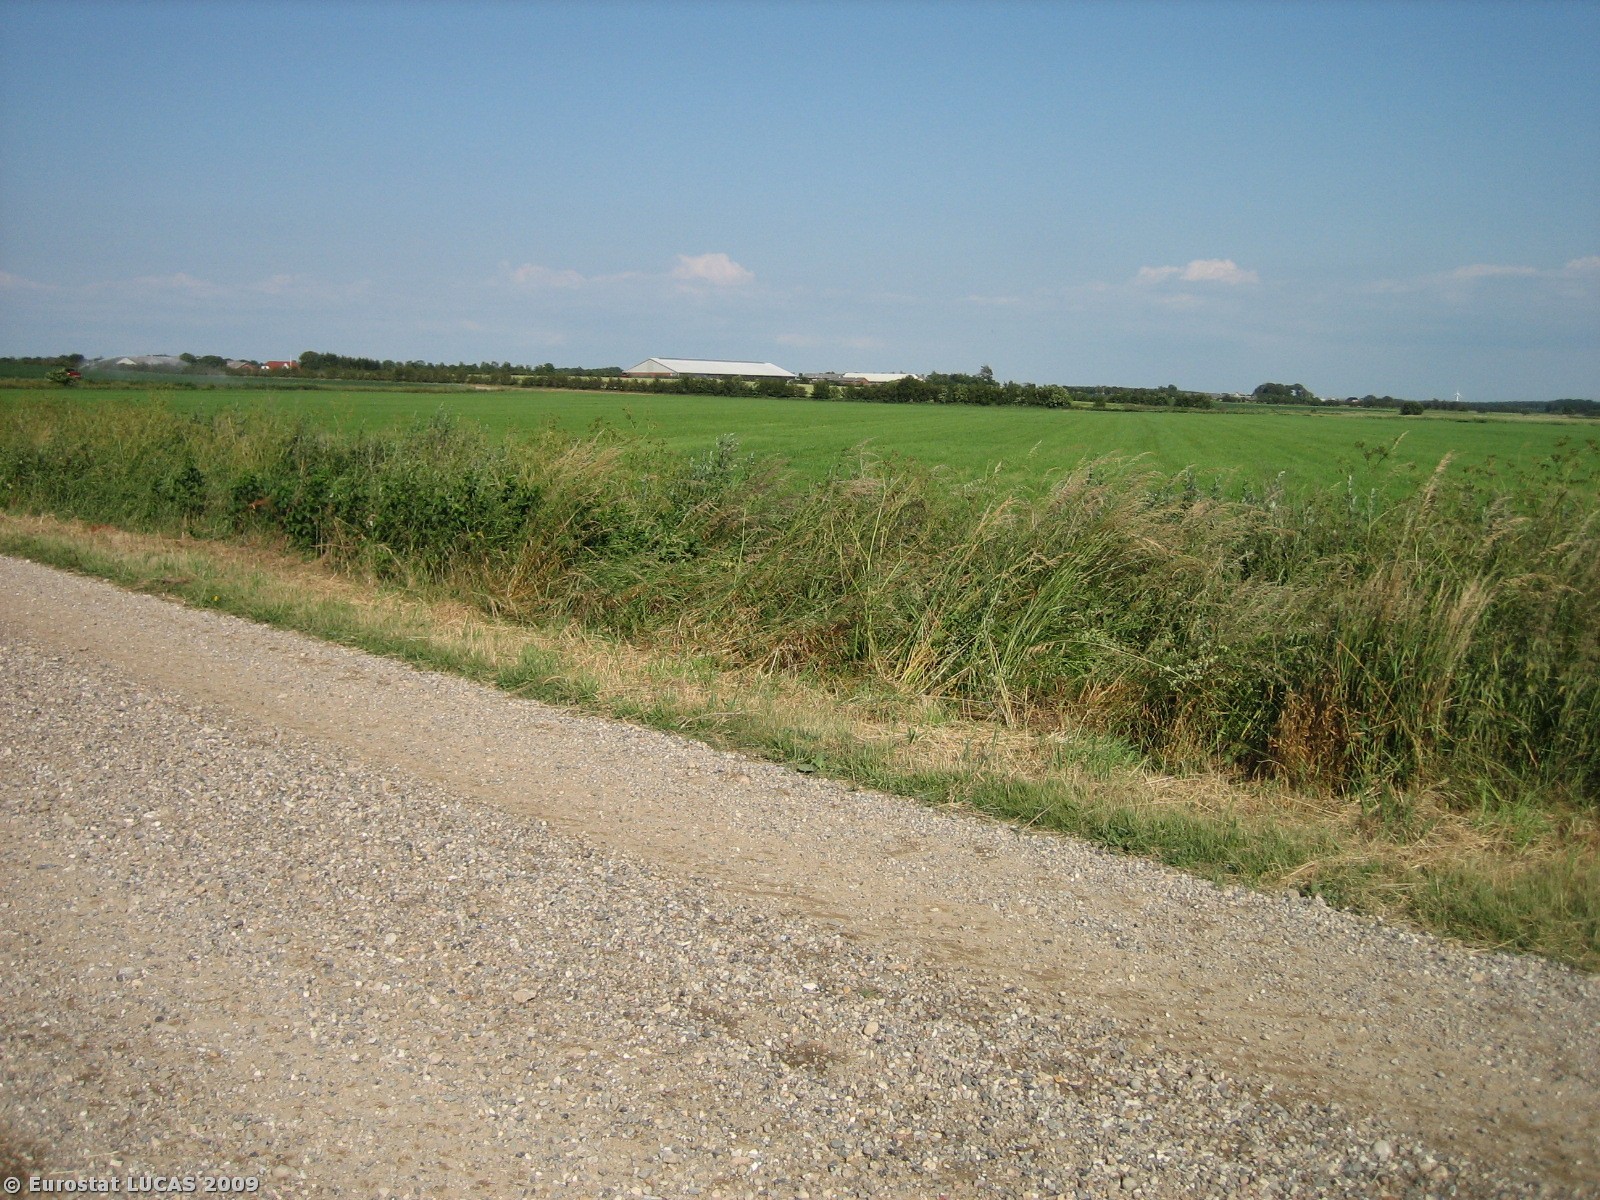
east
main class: Cropland
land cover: Barley
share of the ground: > 75 %
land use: Agriculture (excluding fallow land and kitchen gardens)
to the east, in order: Barley; Grass margins; Ditches and canals; Grass margins; Tracks; Grass margins; Temporary grasslands
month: July
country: DK
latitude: 55.3736
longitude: 8.8491
